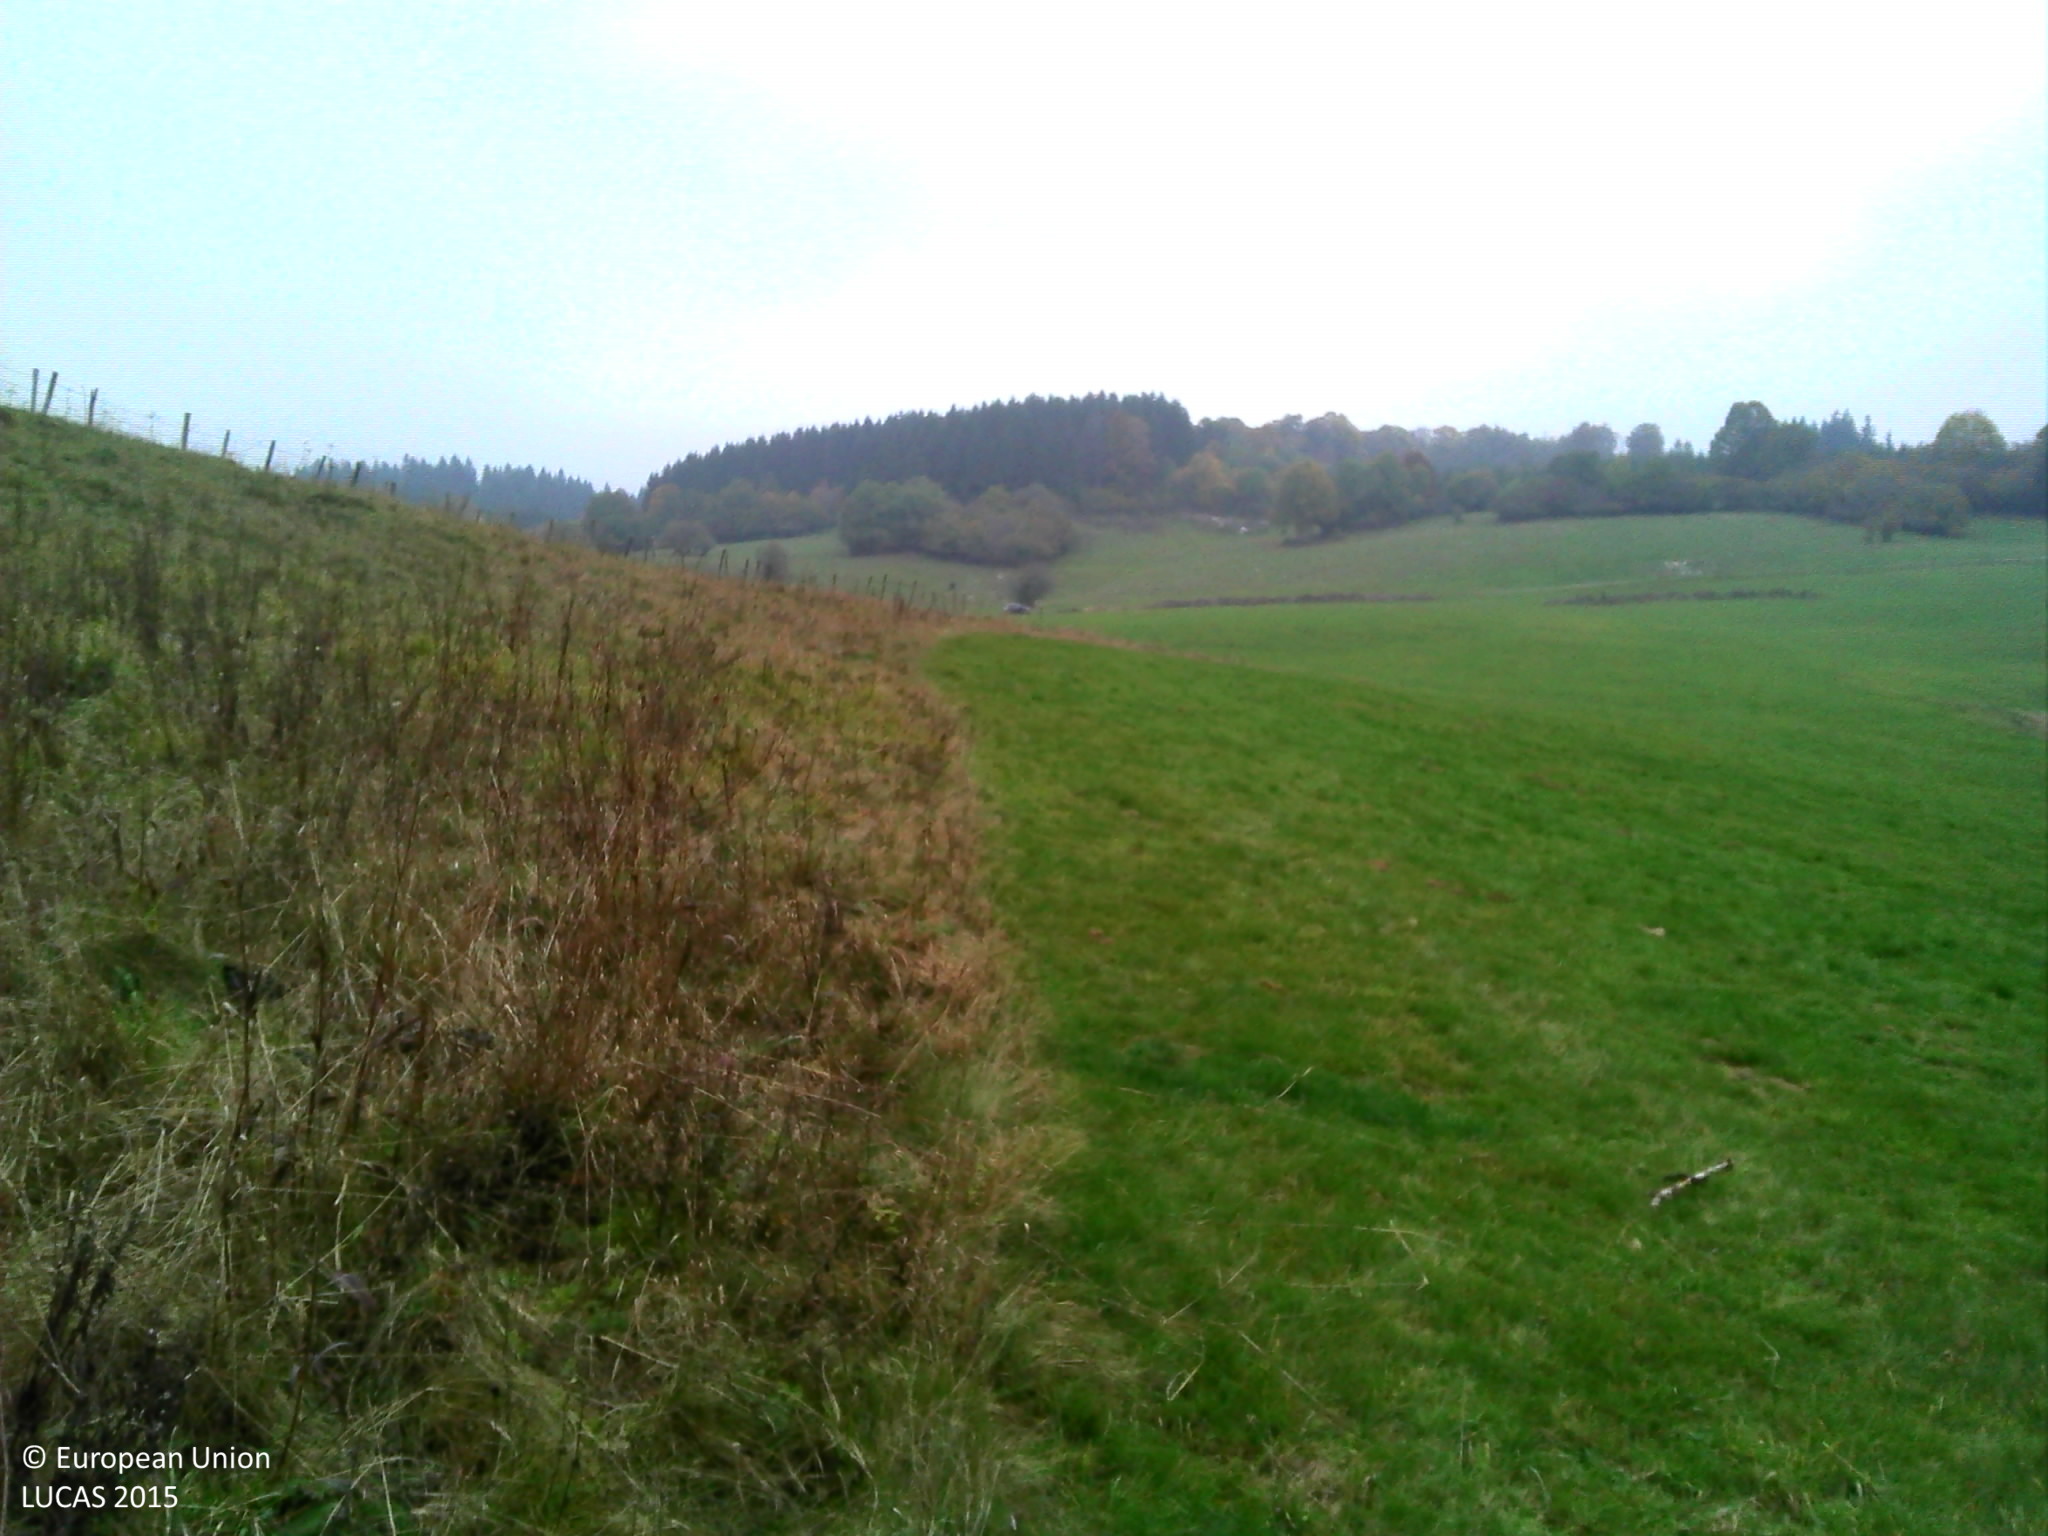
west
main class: Grassland
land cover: Grassland without tree/shrub cover
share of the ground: > 75 %
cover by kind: herbaceous plants 100 %
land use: Agriculture (excluding fallow land and kitchen gardens)
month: October
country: FR
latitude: 46.9131
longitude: 6.1553
